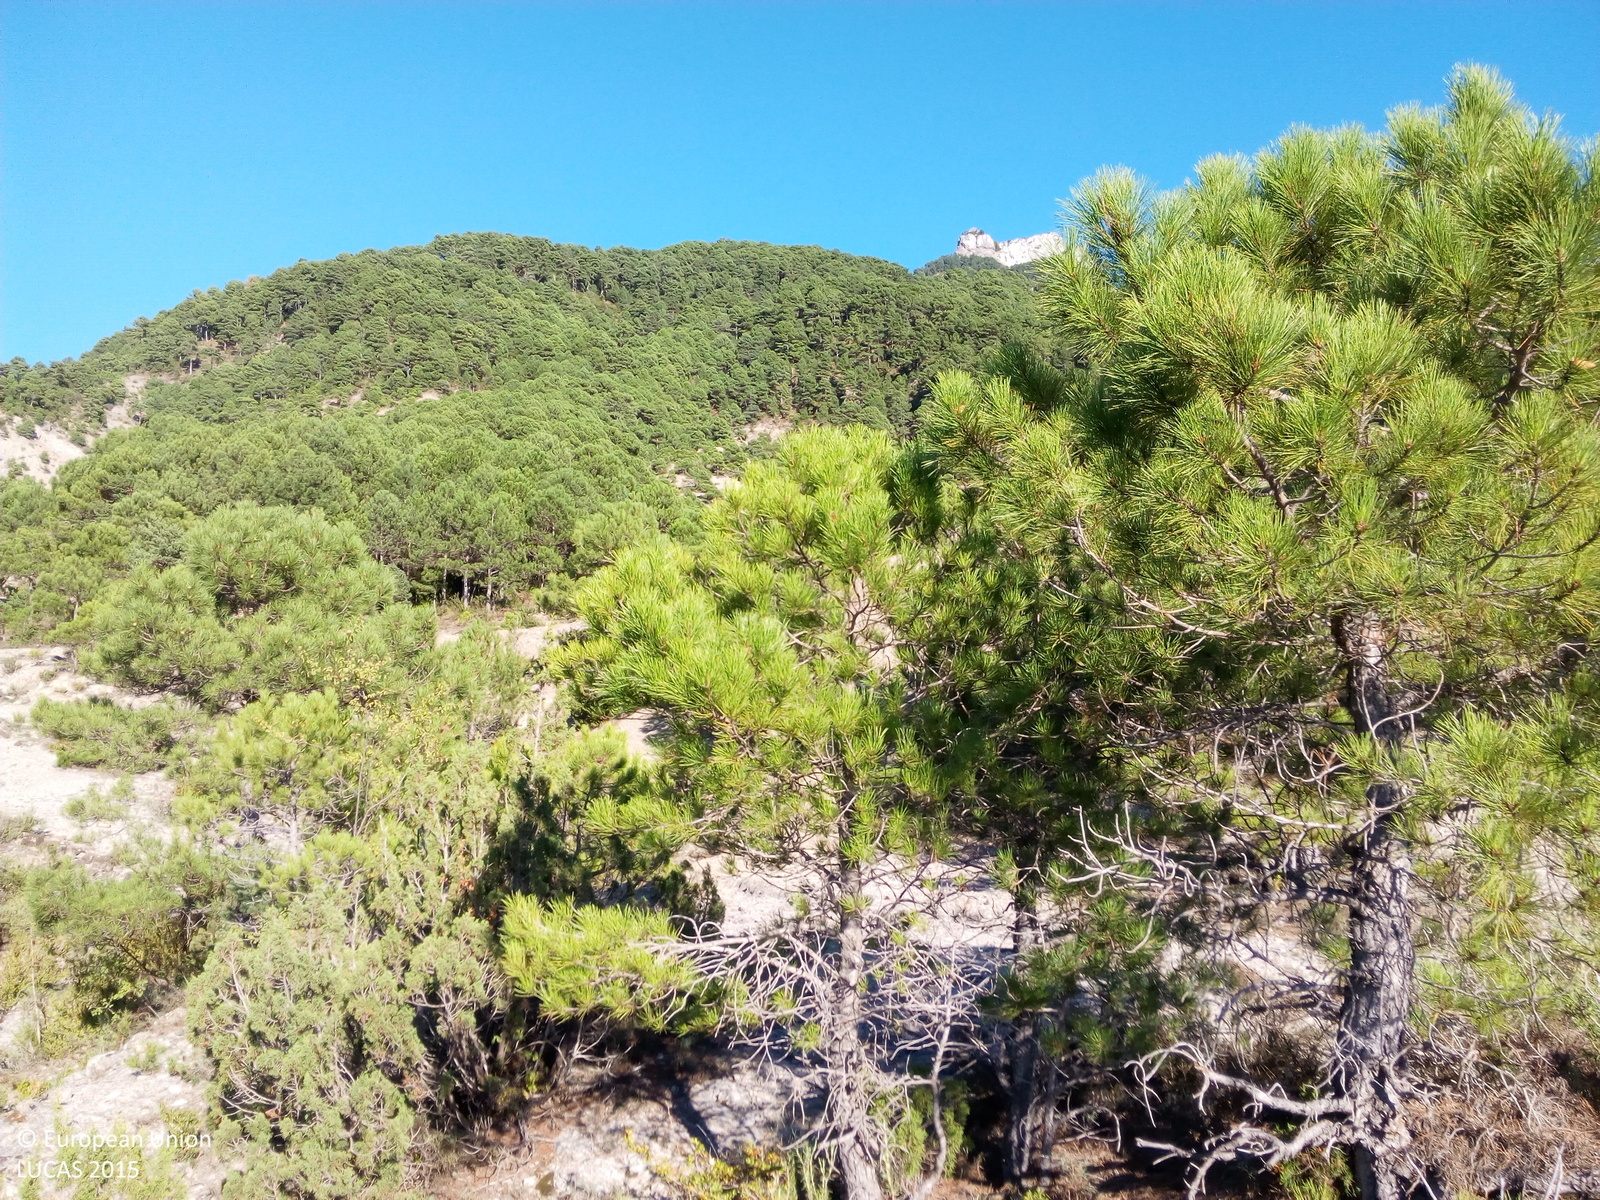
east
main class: Woodland
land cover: Pine dominated coniferous woodland
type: coniferous forest of the mediterranean region
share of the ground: > 75 %
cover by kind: coniferous forest trees 80 %, consolidated bare surface 20 %
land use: Semi-natural and natural areas not in use
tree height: > 5 m
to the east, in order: Pine dominated coniferous woodland
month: August
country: ES
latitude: 42.5211
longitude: 0.1793
